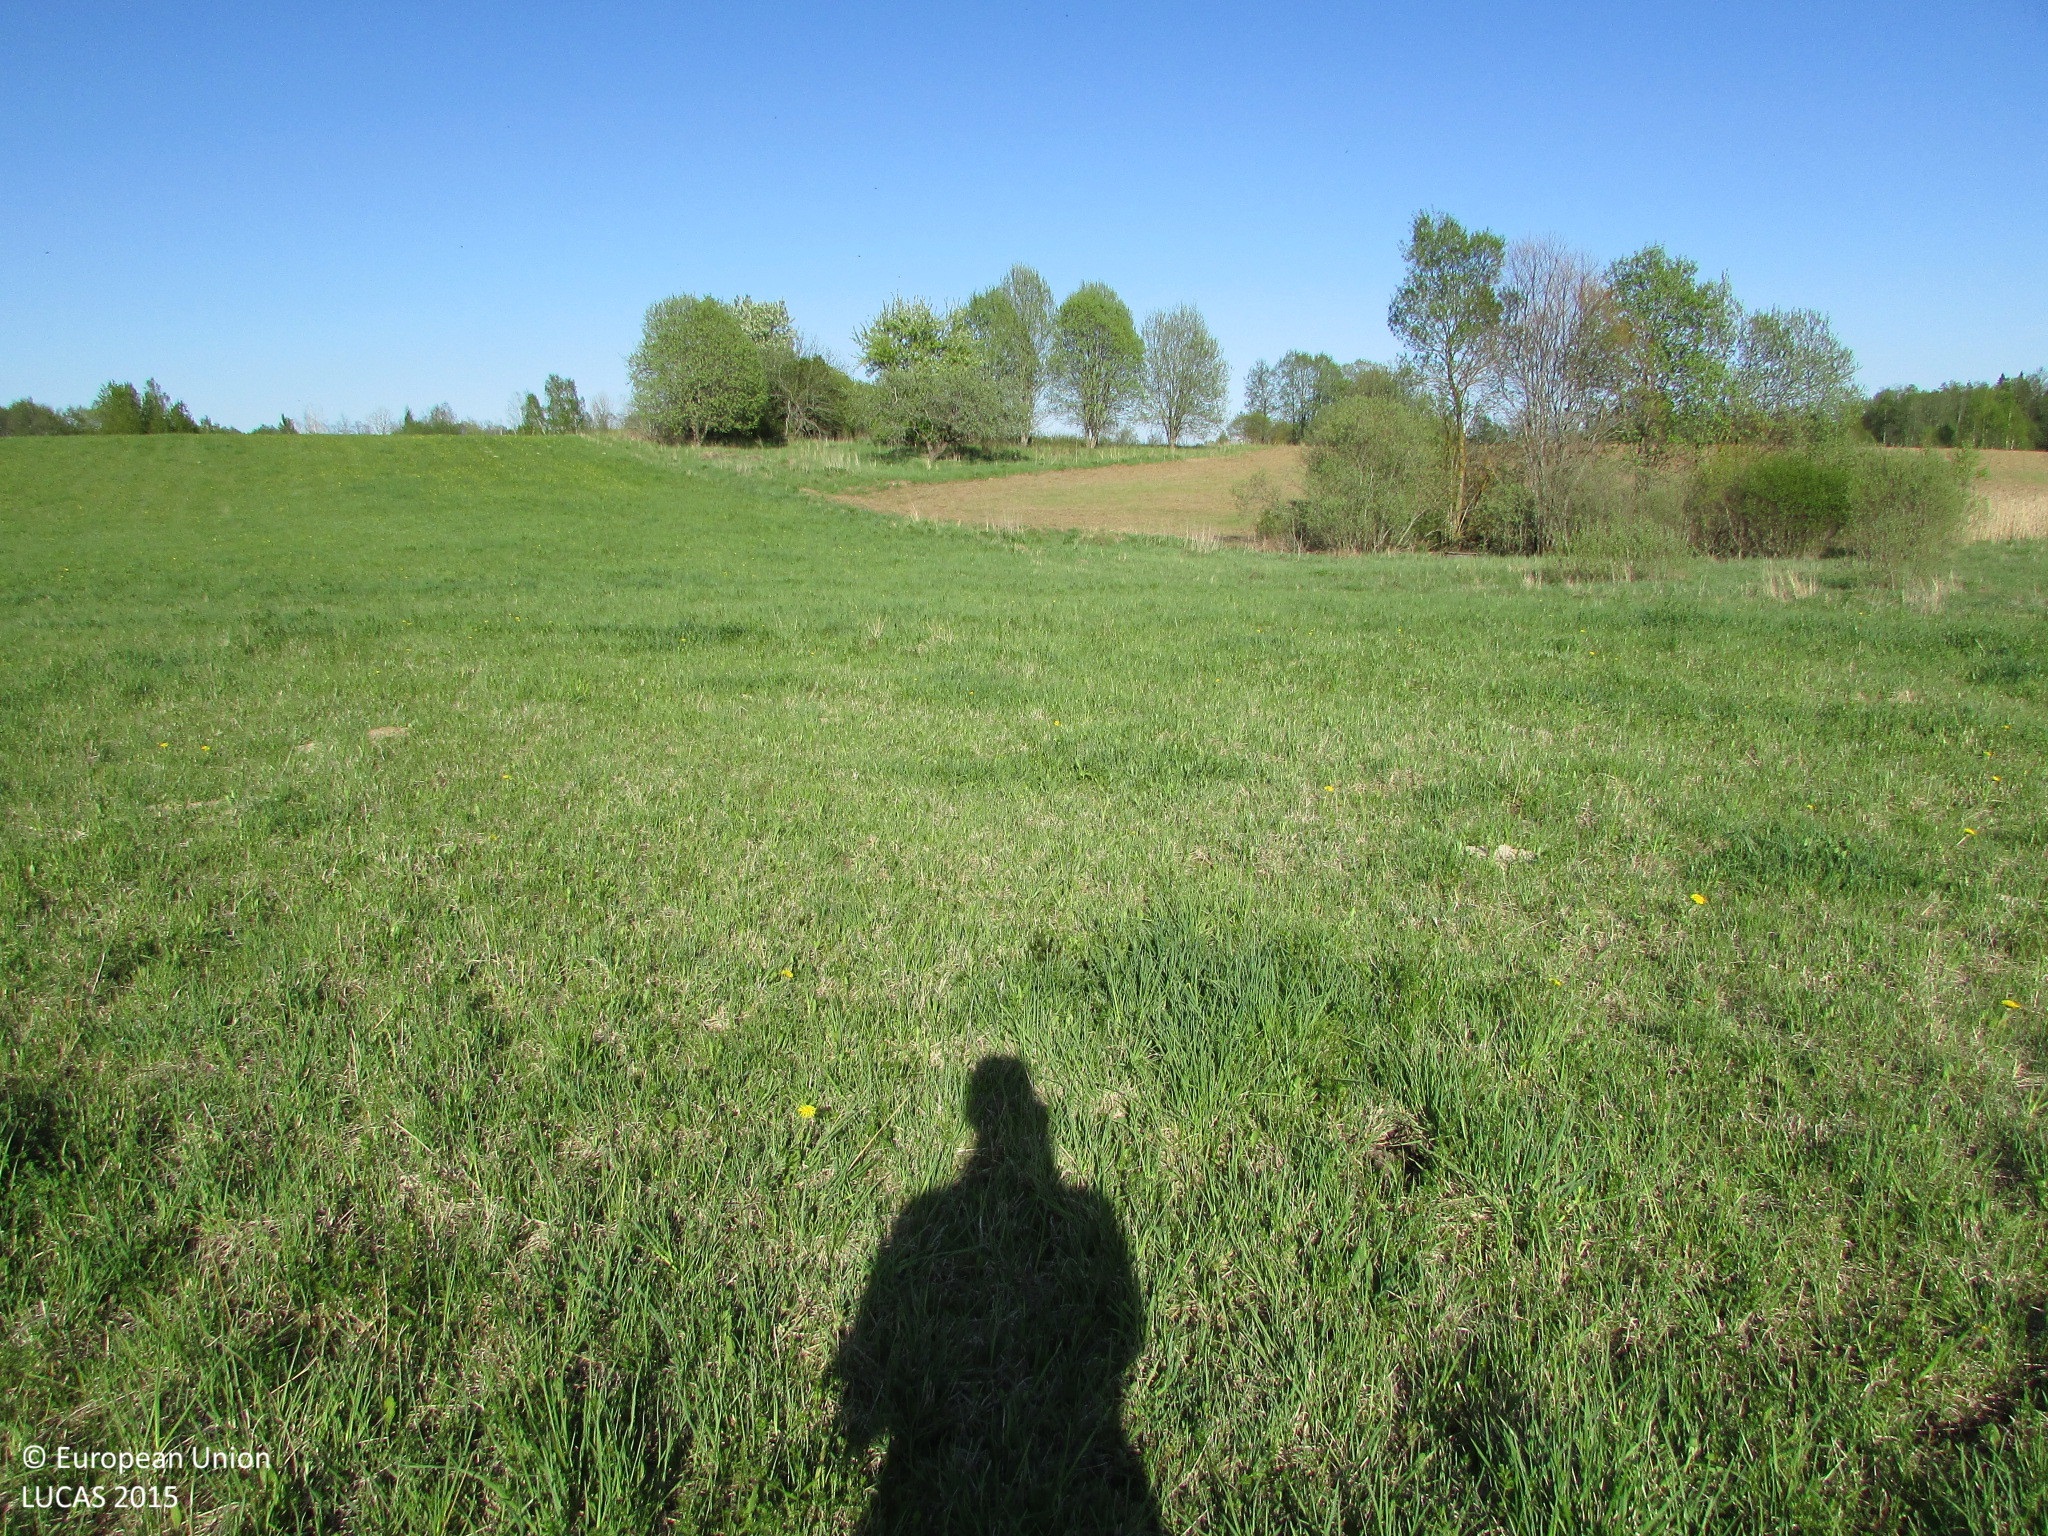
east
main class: Grassland
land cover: Grassland without tree/shrub cover
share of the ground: > 75 %
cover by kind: herbaceous plants 100 %
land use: Agriculture (excluding fallow land and kitchen gardens)
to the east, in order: Grassland without tree/shrub cover; Oats; Grassland without tree/shrub cover; Broadleaved woodland; Grassland without tree/shrub cover; Oats
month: May
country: LV
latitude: 55.9019
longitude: 27.5701
